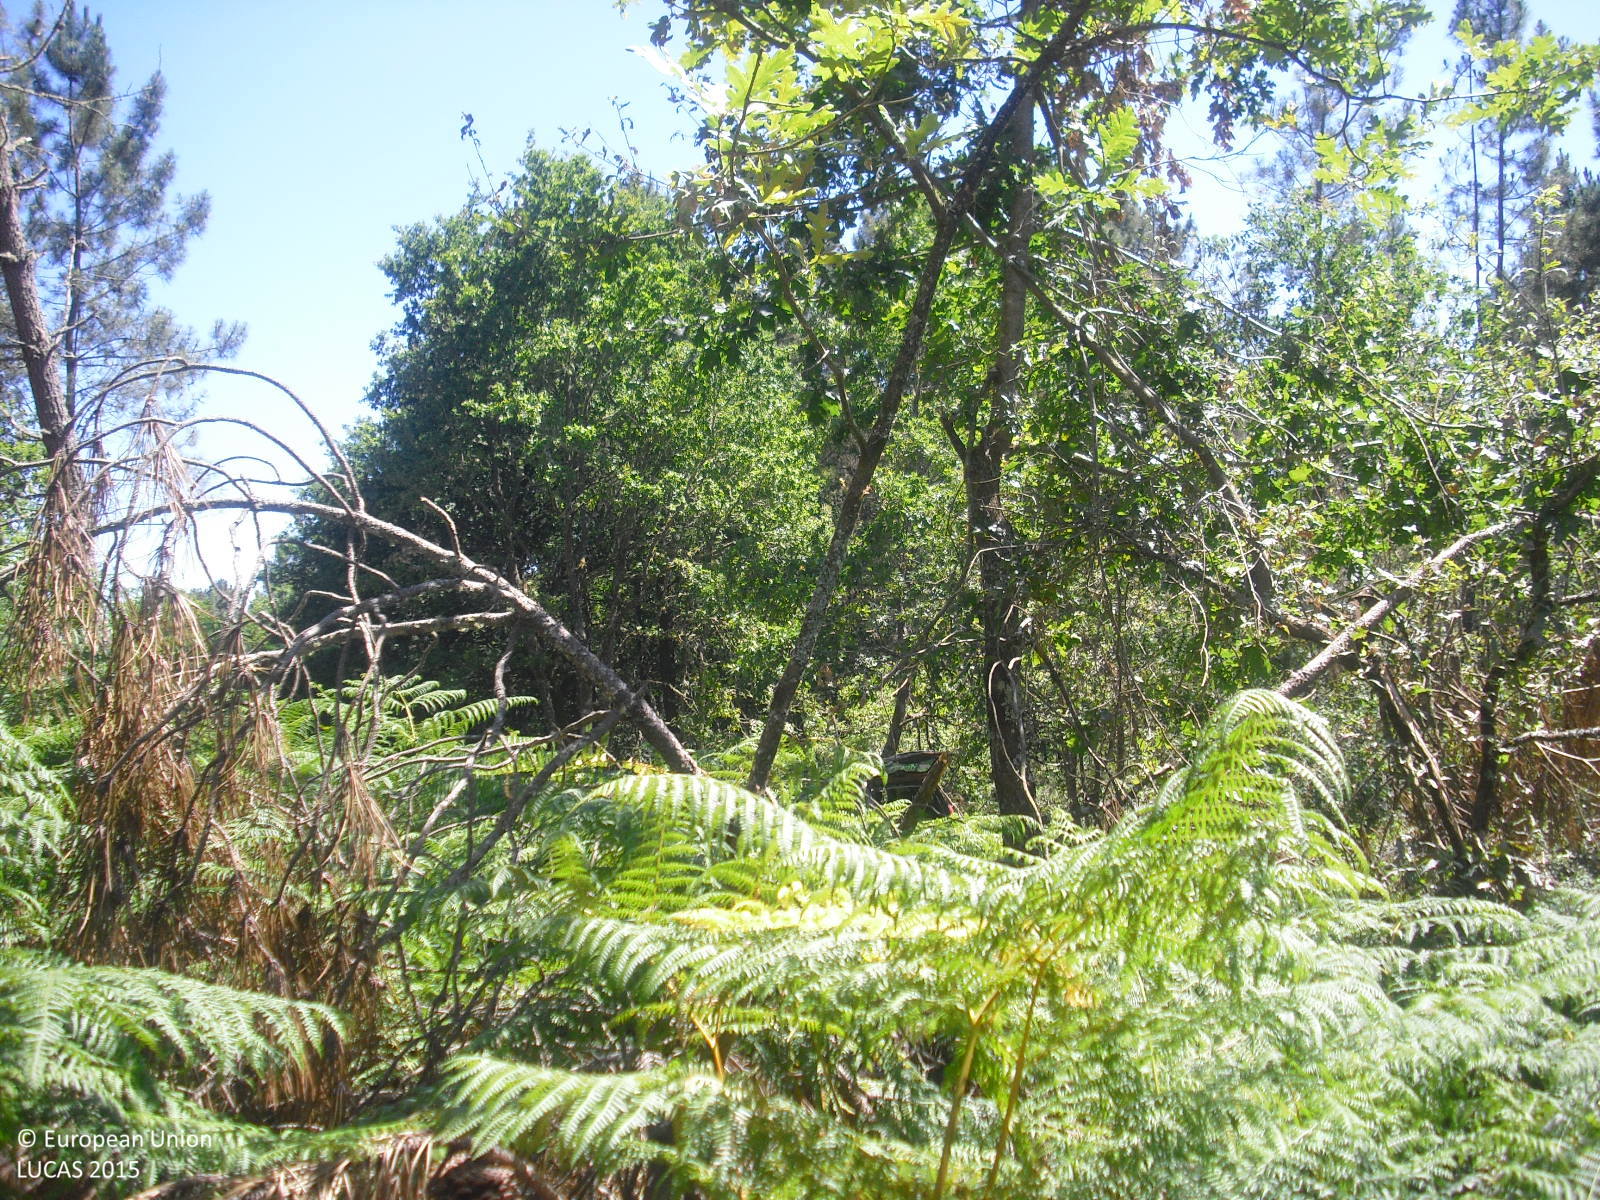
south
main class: Woodland
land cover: Pine dominated mixed woodland
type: hemiboreal forest and nemoral coniferous forest and mixed broadleaved-coniferous forest
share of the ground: 25 - 50 %
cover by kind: coniferous forest trees 40 %, shrubs 35 %, broadleaved forest trees 15 %, herbaceous plants 10 %
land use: Forestry
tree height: > 5 m
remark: Clear cut
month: June
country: ES
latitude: 42.4517
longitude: -7.7675
